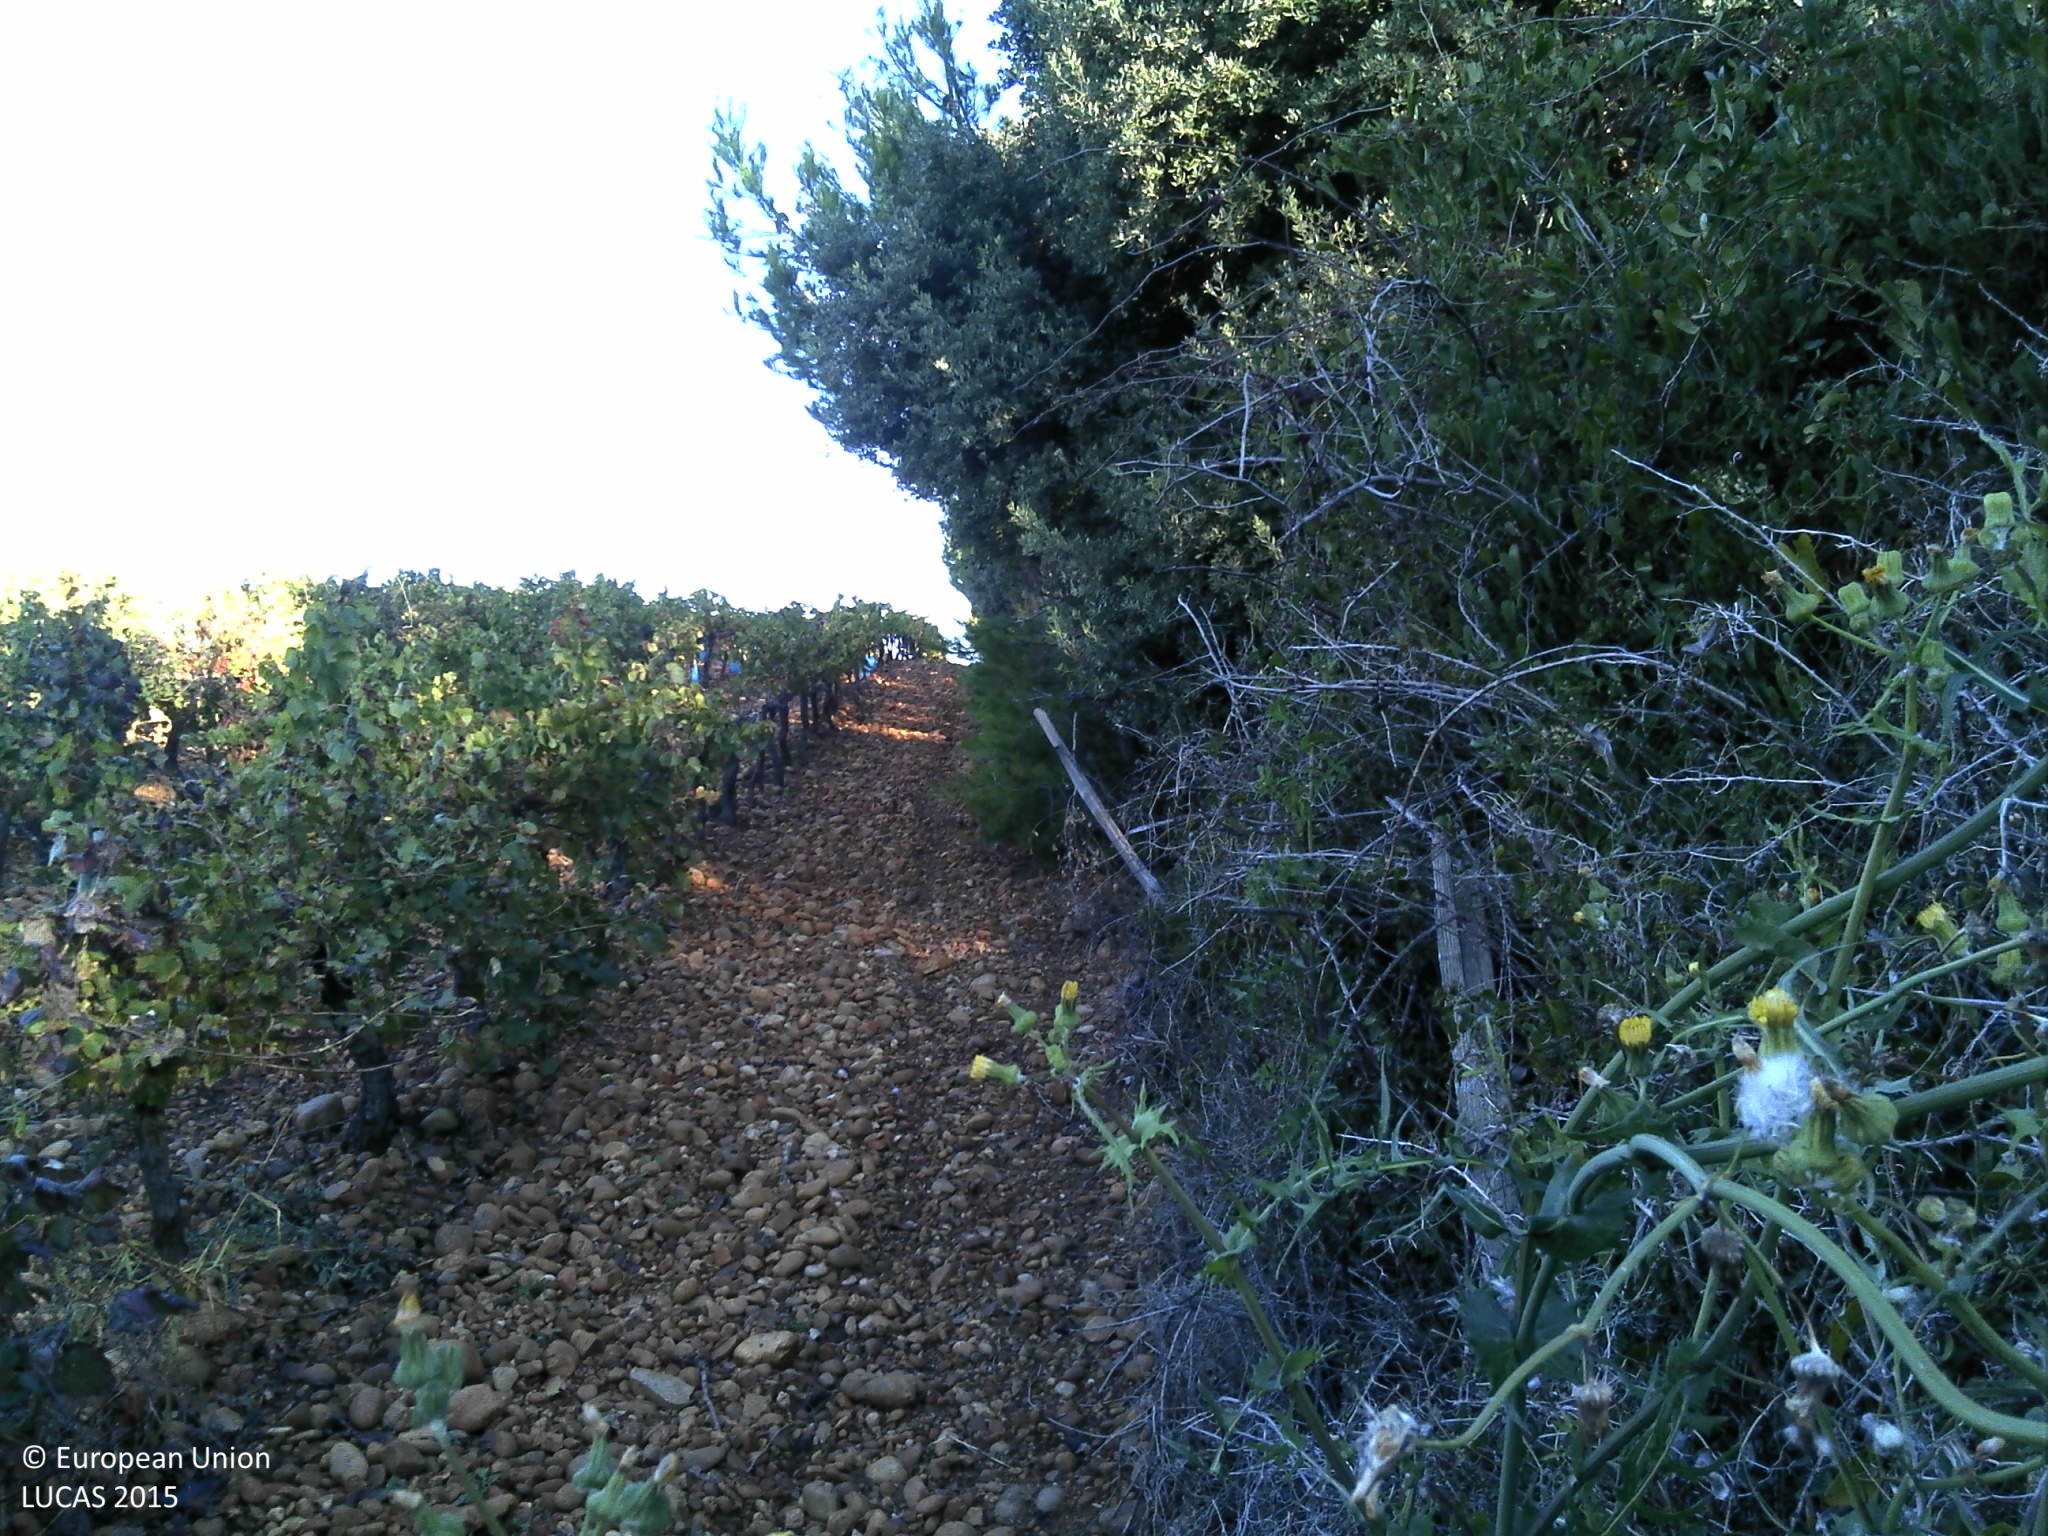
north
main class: Shrubland
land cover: Shrubland with sparse tree cover
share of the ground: > 75 %
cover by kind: shrubs 65 %, herbaceous plants 30 %, broadleaved forest trees 5 %
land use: Abandoned areas
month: October
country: FR
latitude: 43.6898
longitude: 4.3395
